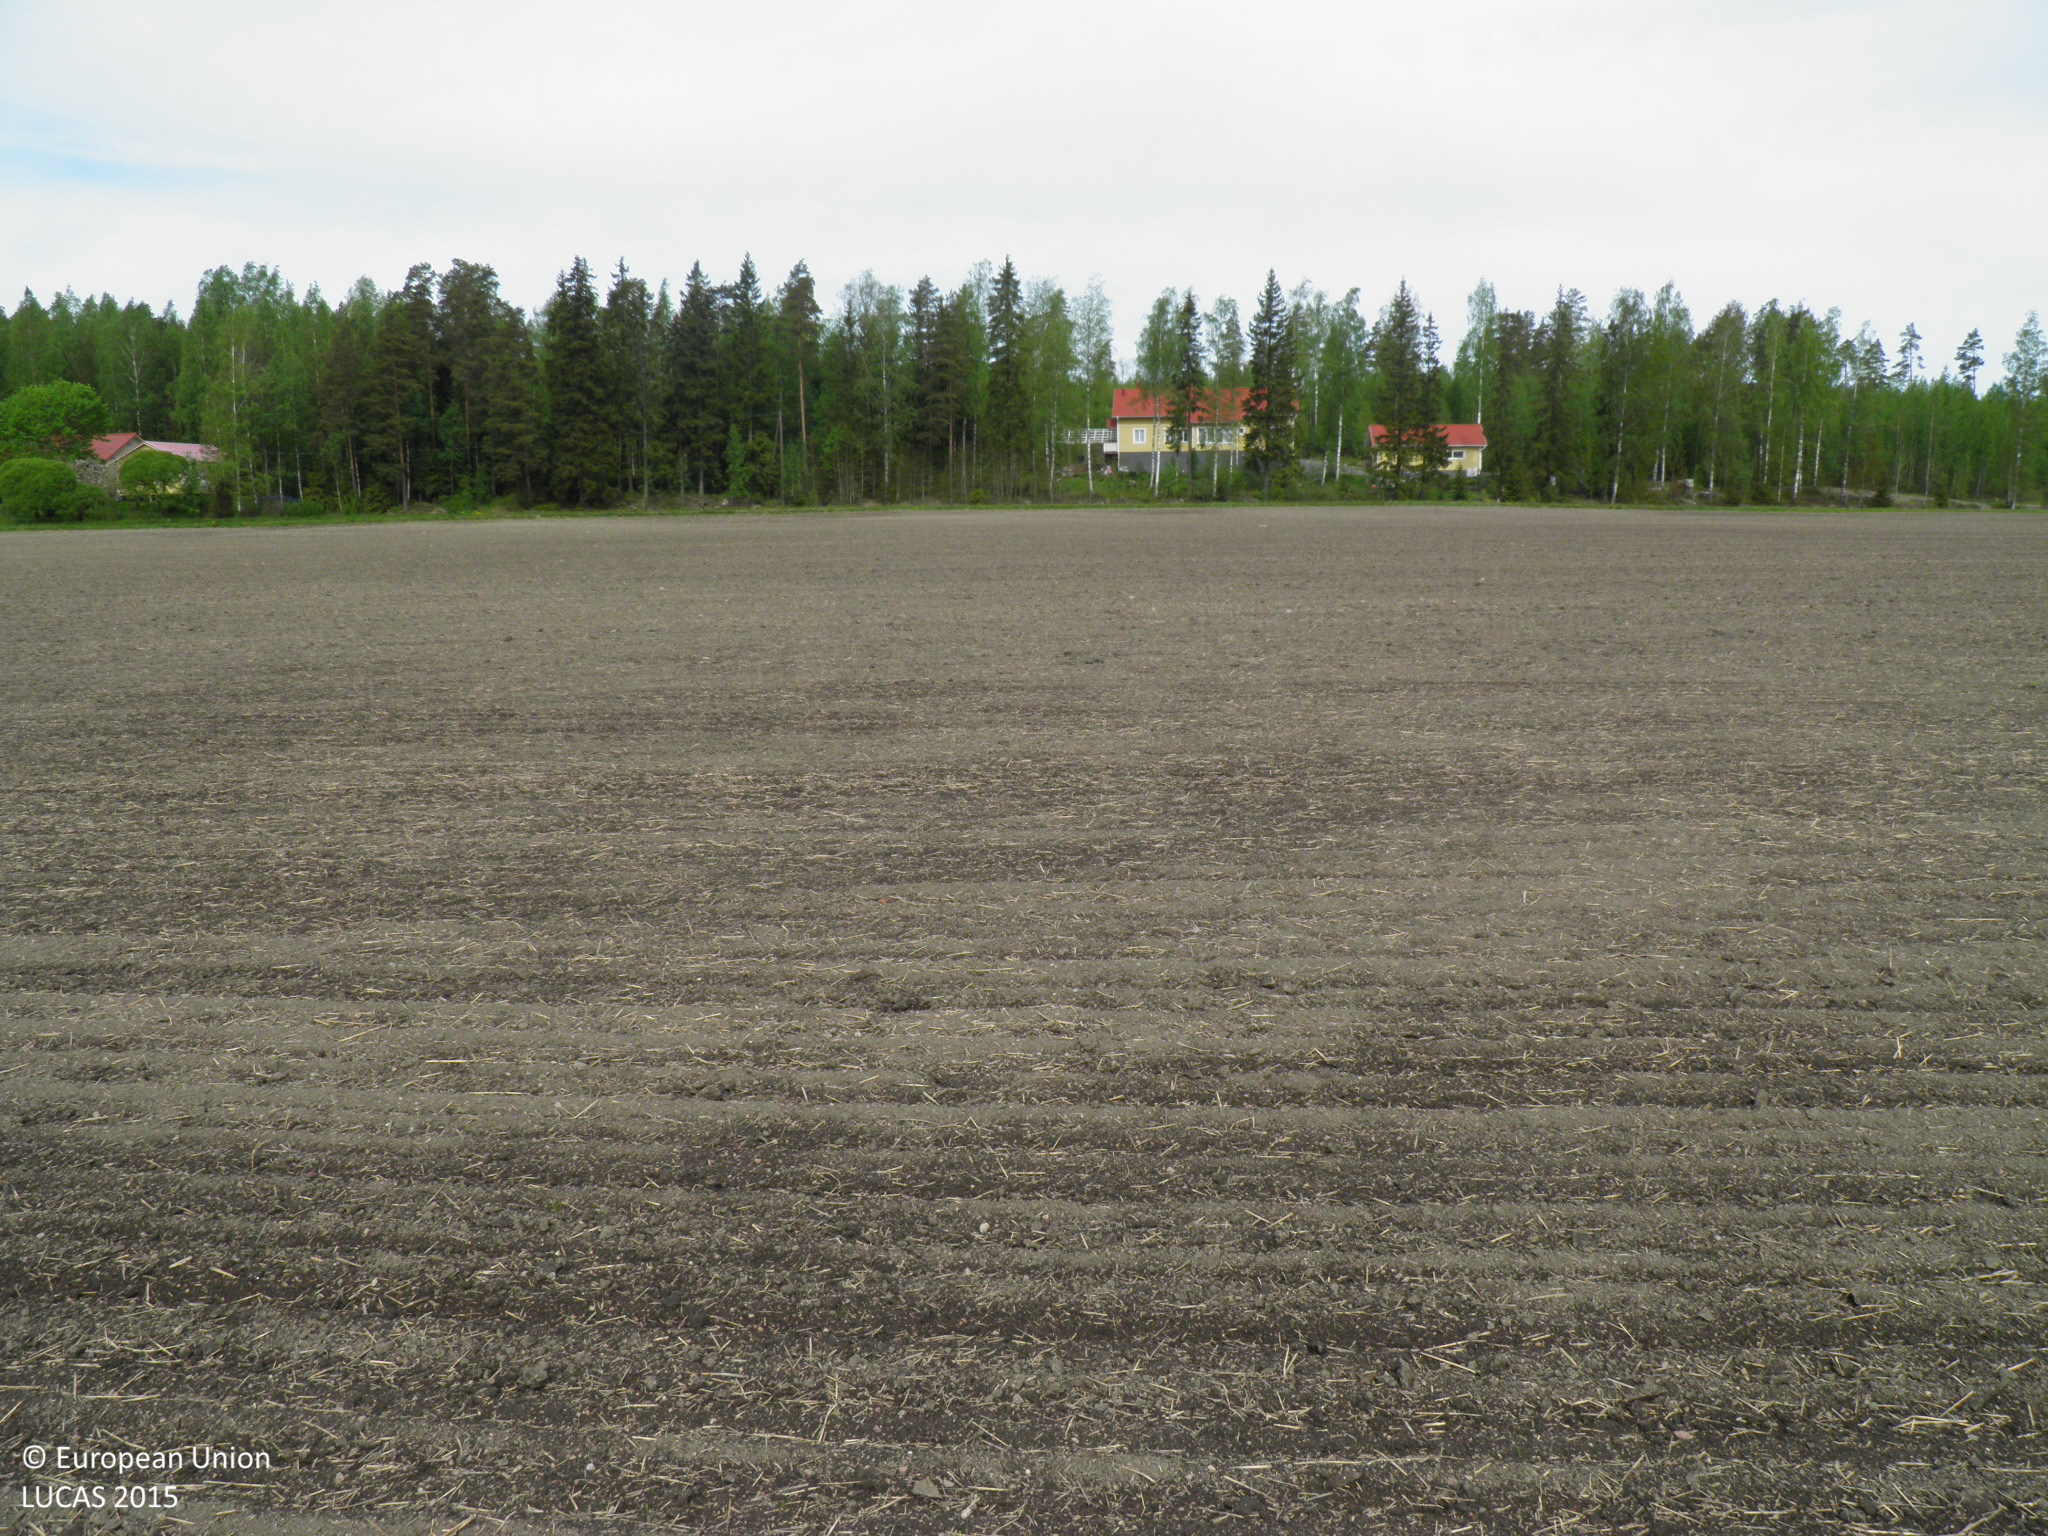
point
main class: Cropland
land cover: Common wheat
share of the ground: < 10 %
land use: Agriculture (excluding fallow land and kitchen gardens)
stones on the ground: < 10 %
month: June
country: FI
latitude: 60.5384
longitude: 22.6674
